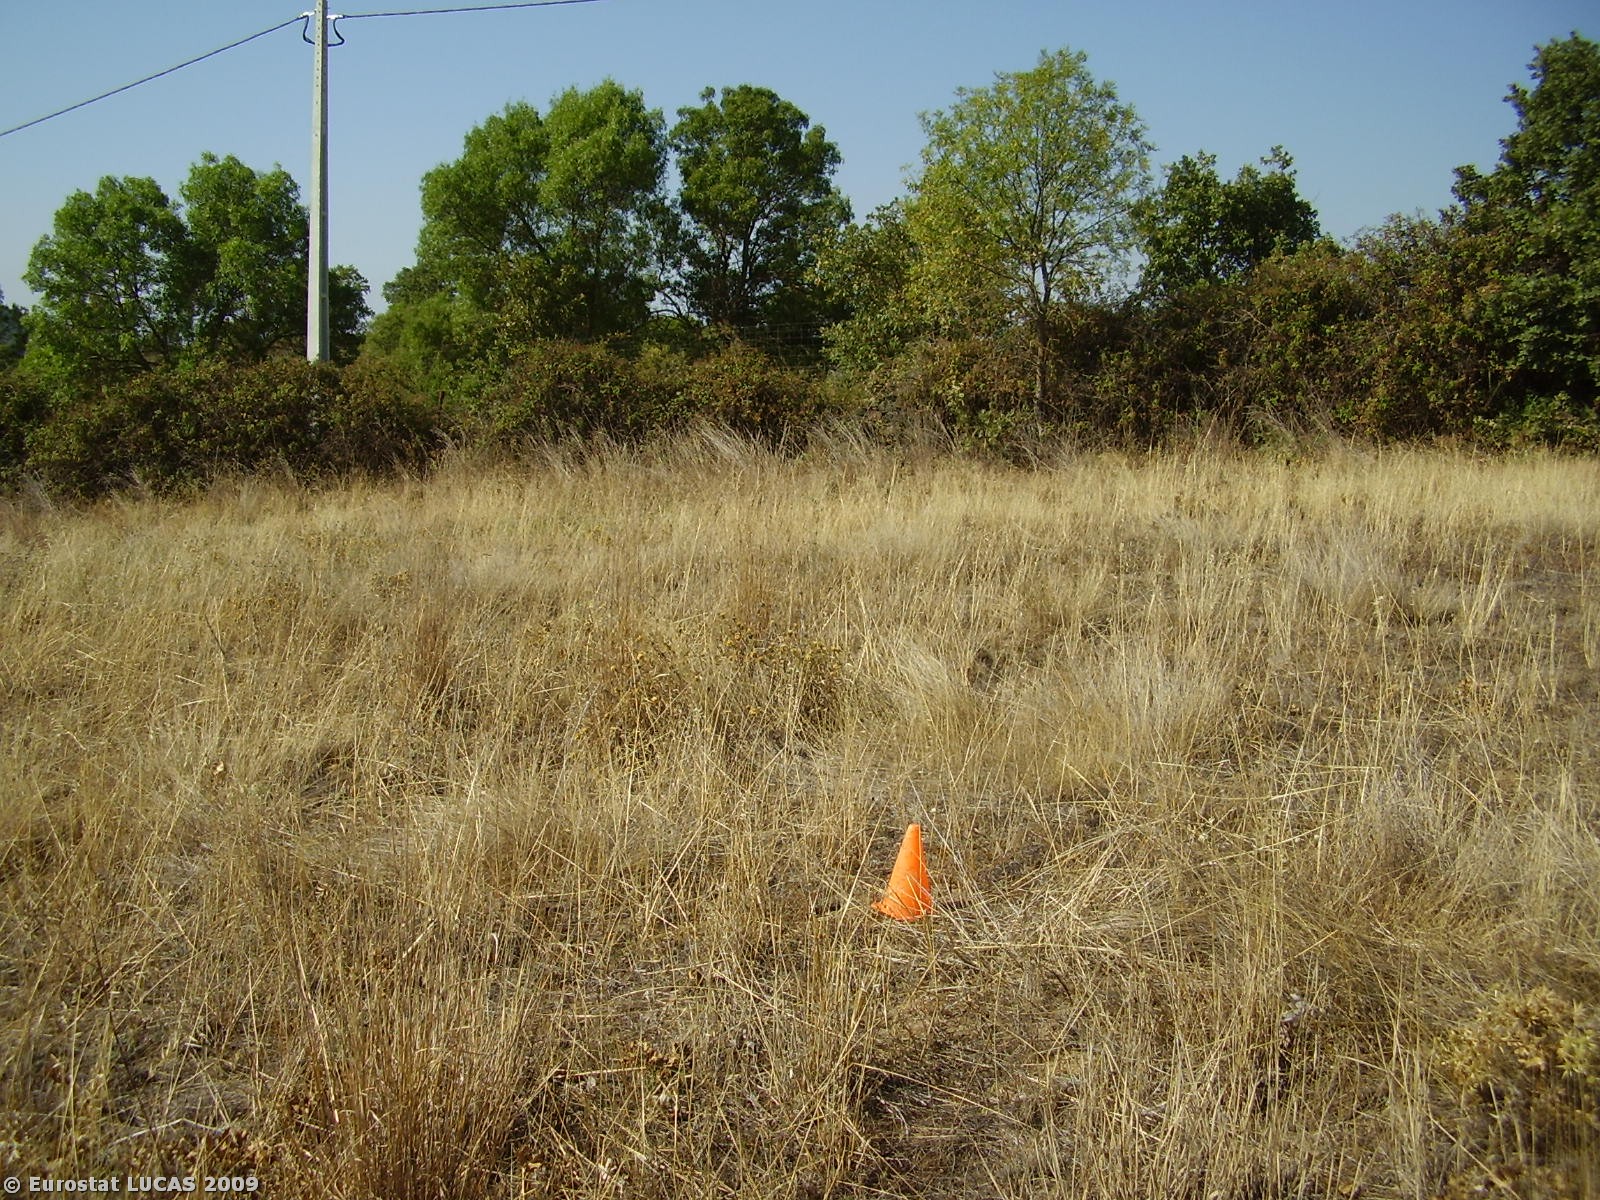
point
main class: Grassland
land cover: Grassland without tree/shrub cover
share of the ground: > 75 %
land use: Fallow land
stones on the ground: > 50 %
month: August
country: PT
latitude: 41.3431
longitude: -6.7291
